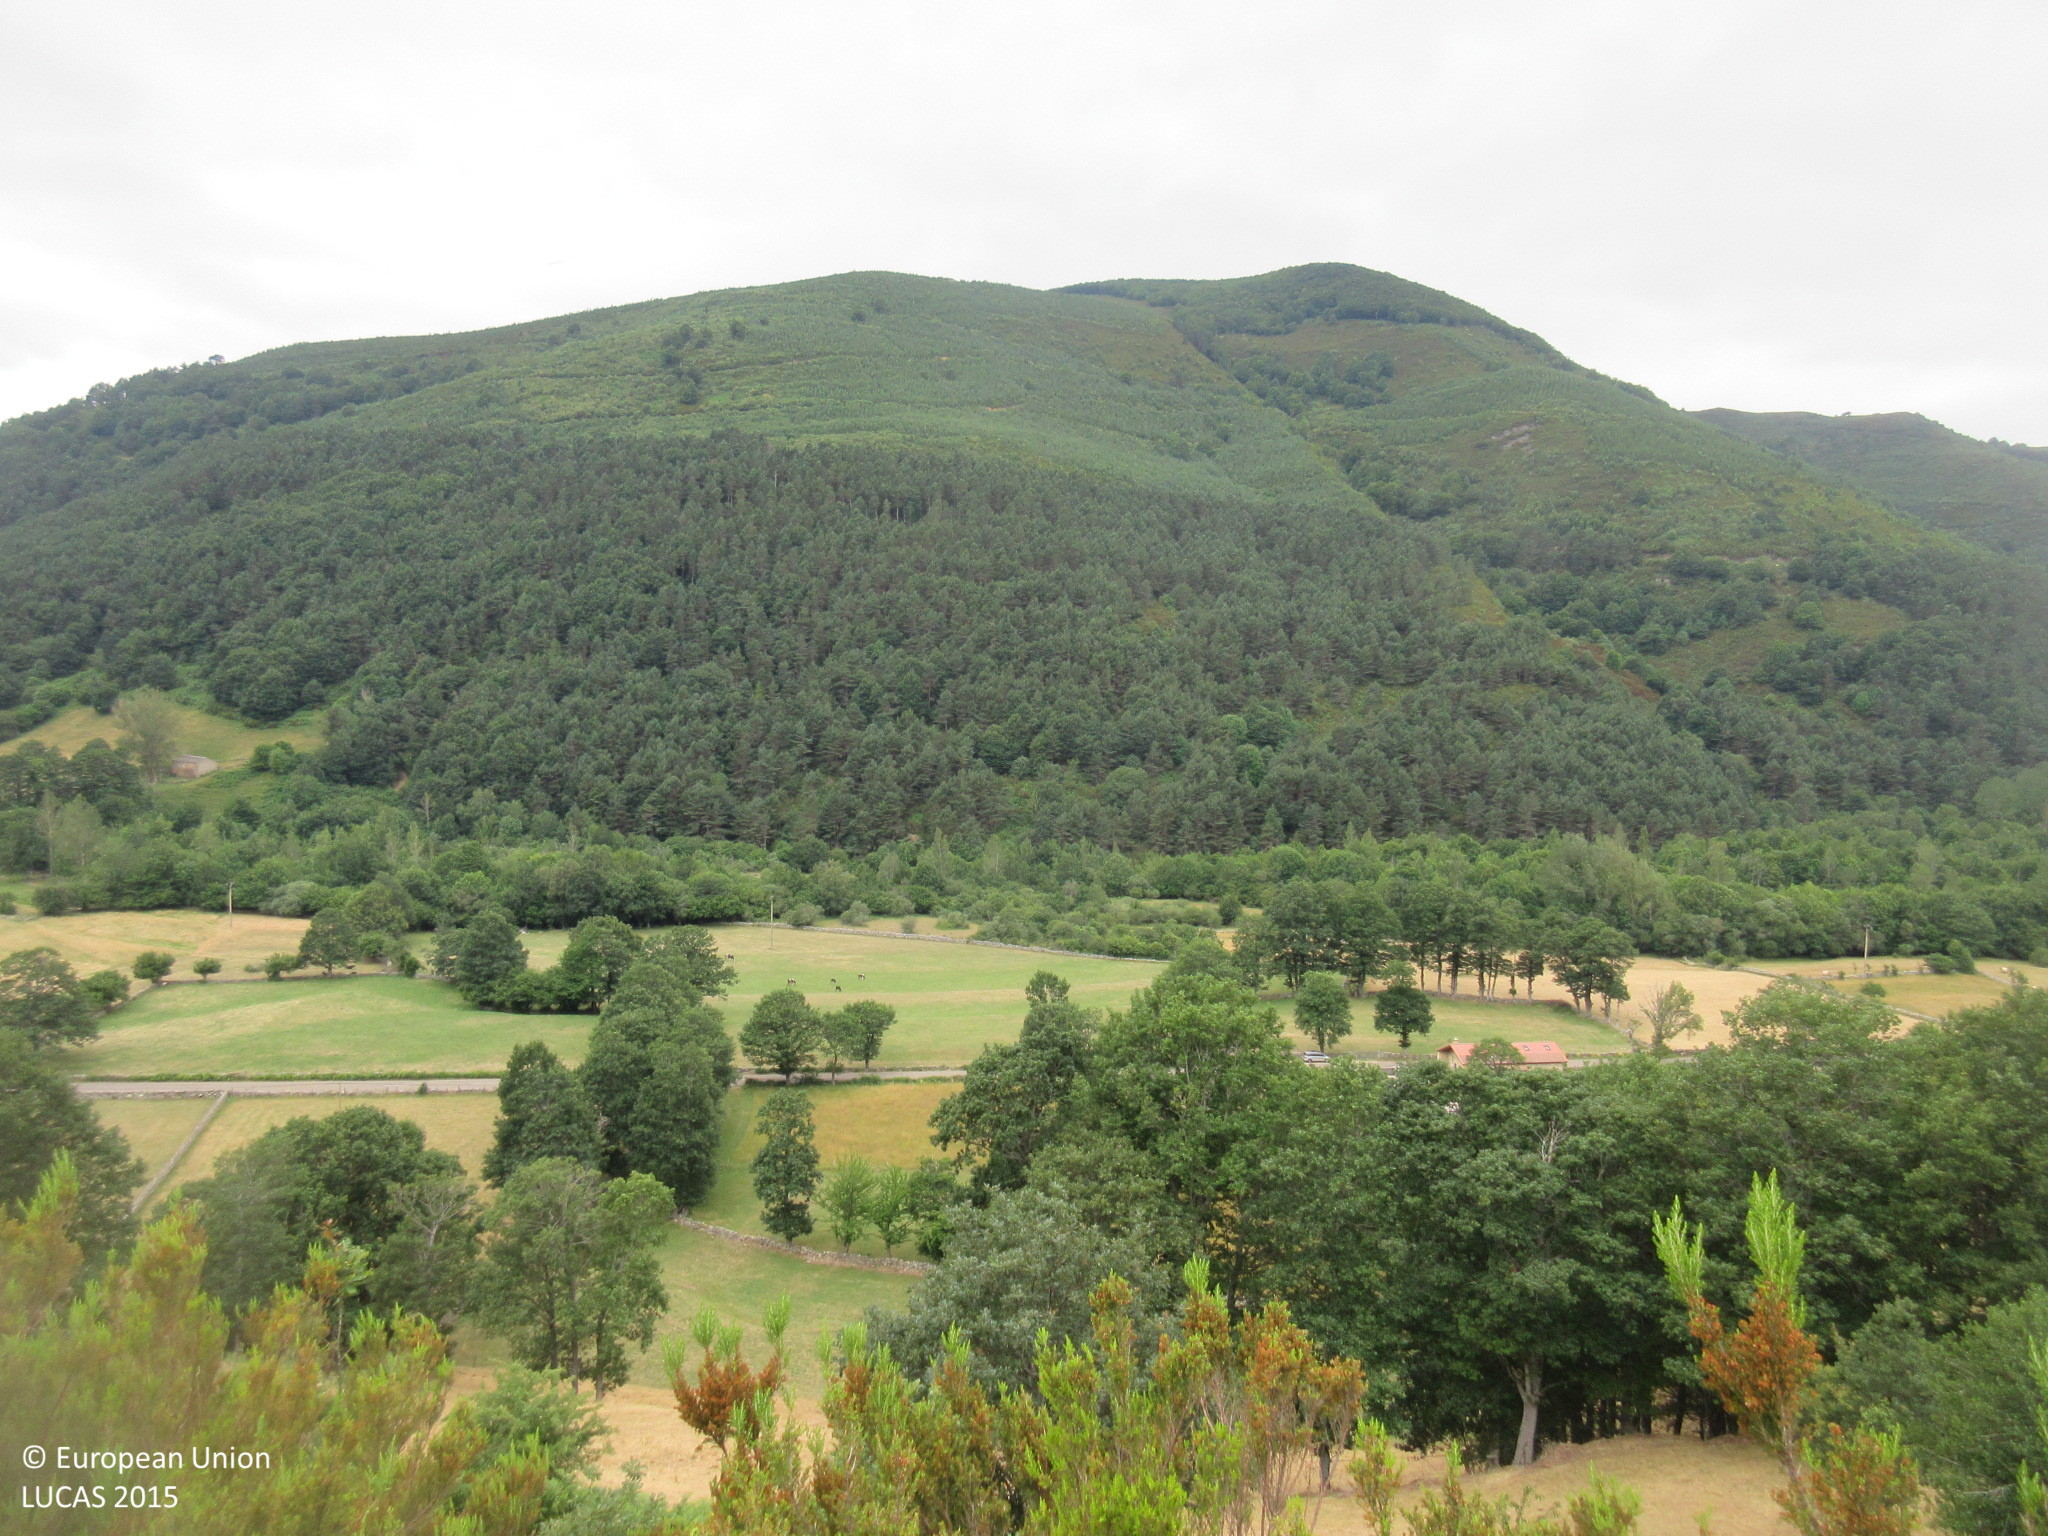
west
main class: Shrubland
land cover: Shrubland without tree cover
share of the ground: > 75 %
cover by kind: shrubs 100 %
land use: Semi-natural and natural areas not in use
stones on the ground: < 10 %
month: July
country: ES
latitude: 43.1071
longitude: -3.5712
